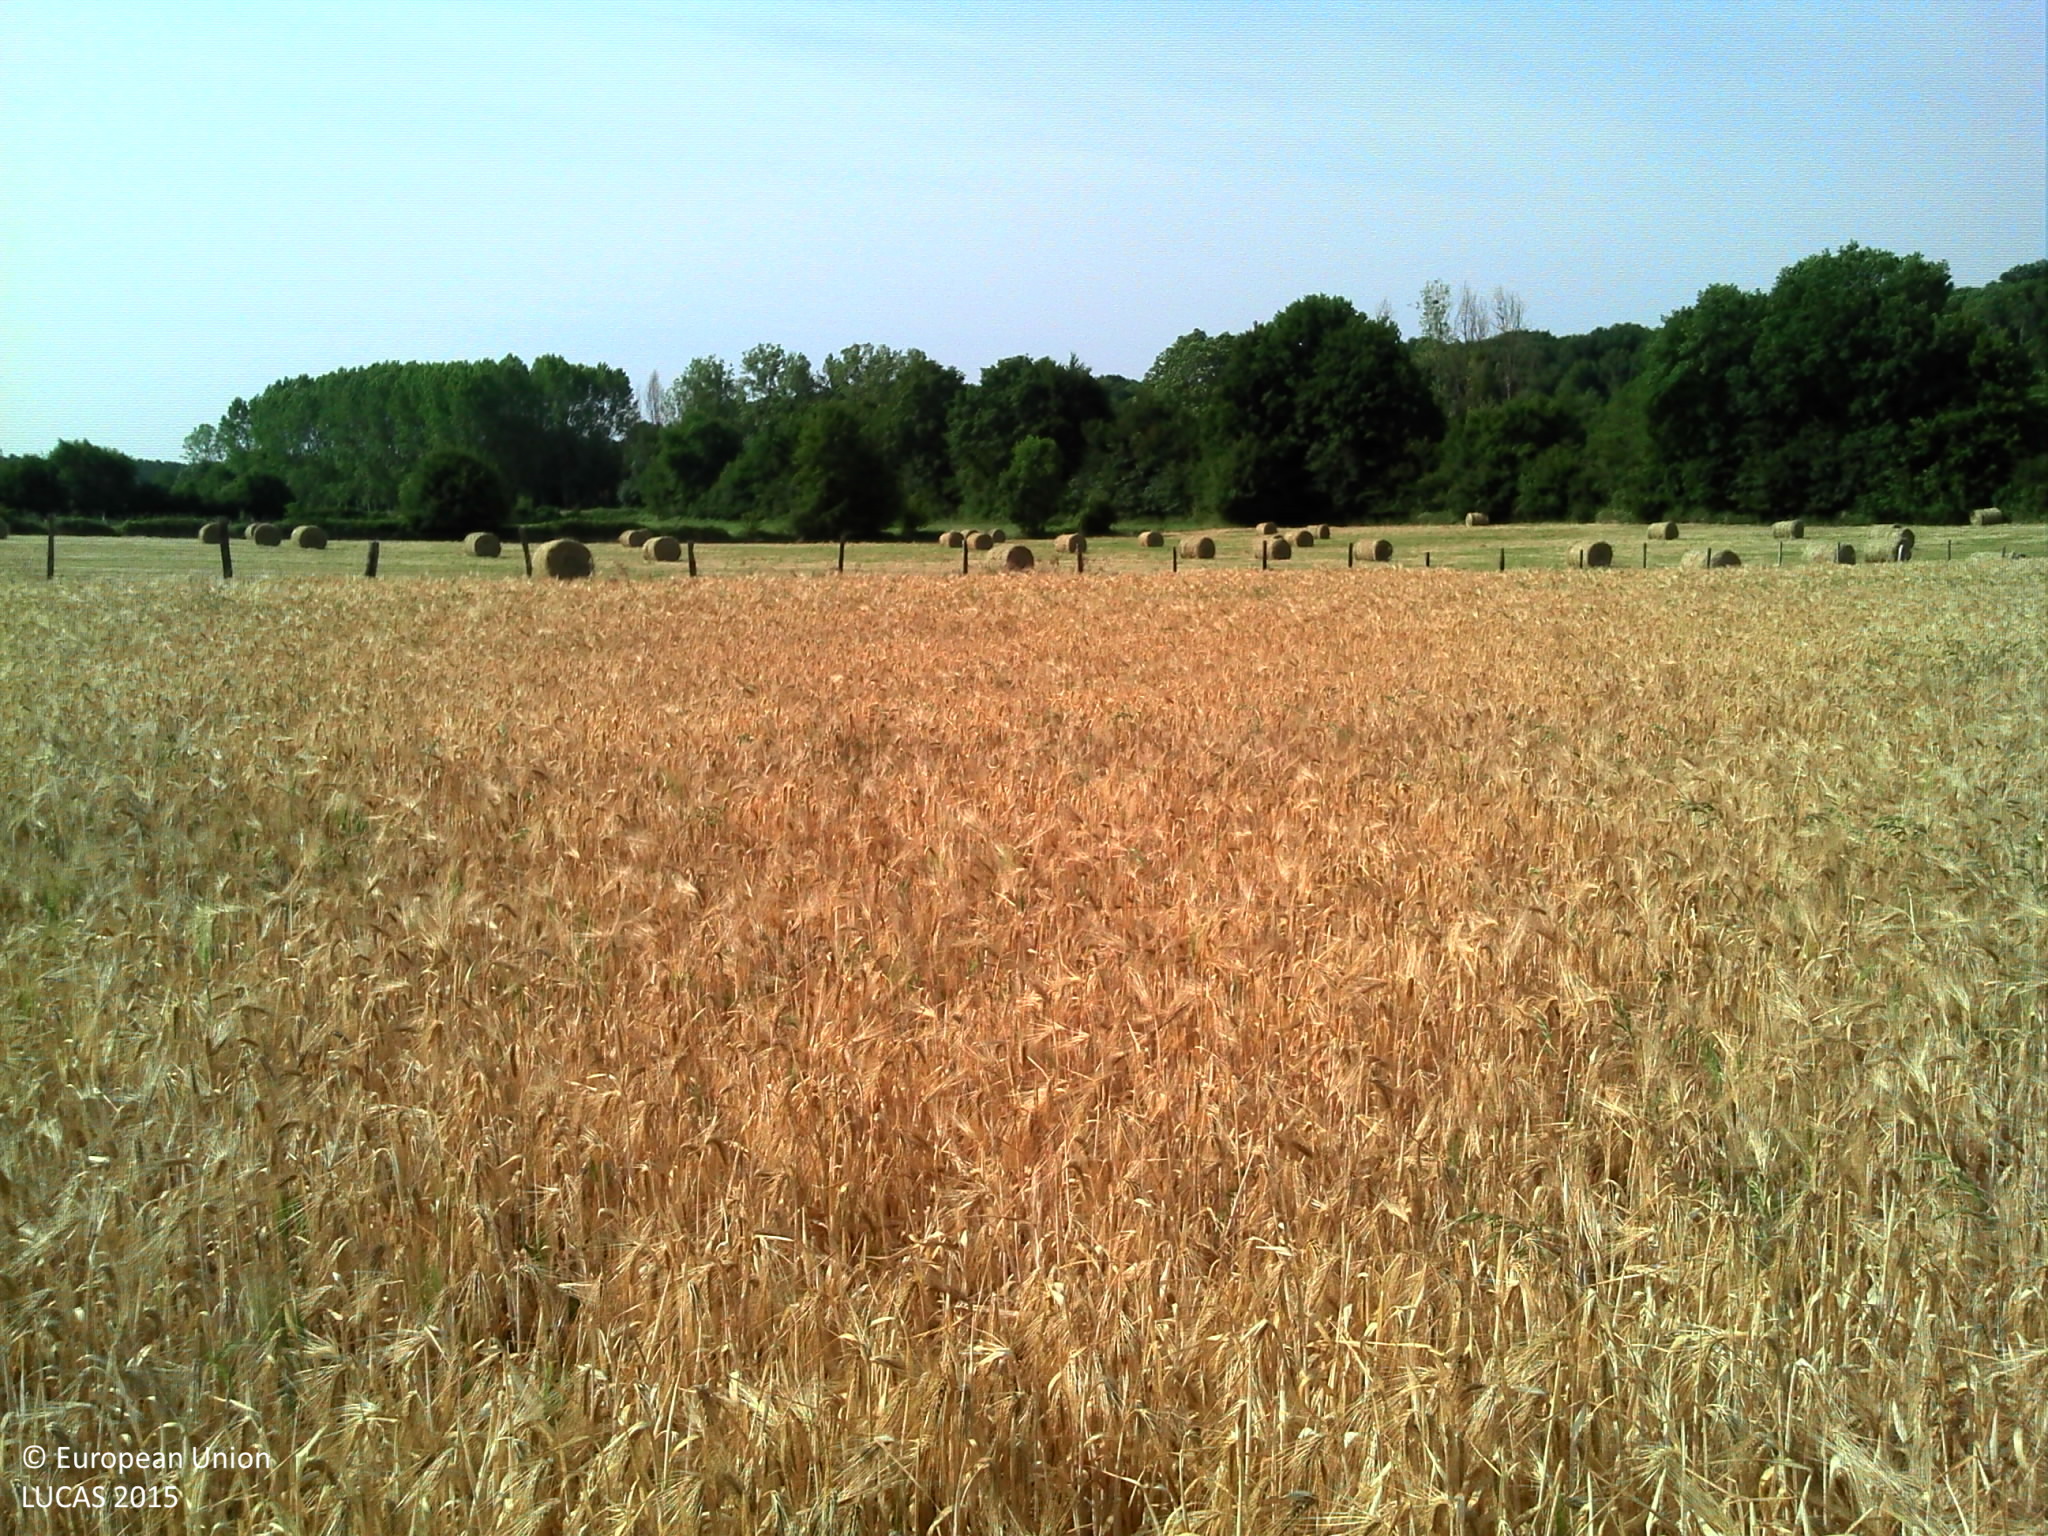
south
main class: Cropland
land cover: Barley
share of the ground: > 75 %
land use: Agriculture (excluding fallow land and kitchen gardens)
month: June
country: FR
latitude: 46.6292
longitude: 0.8550
